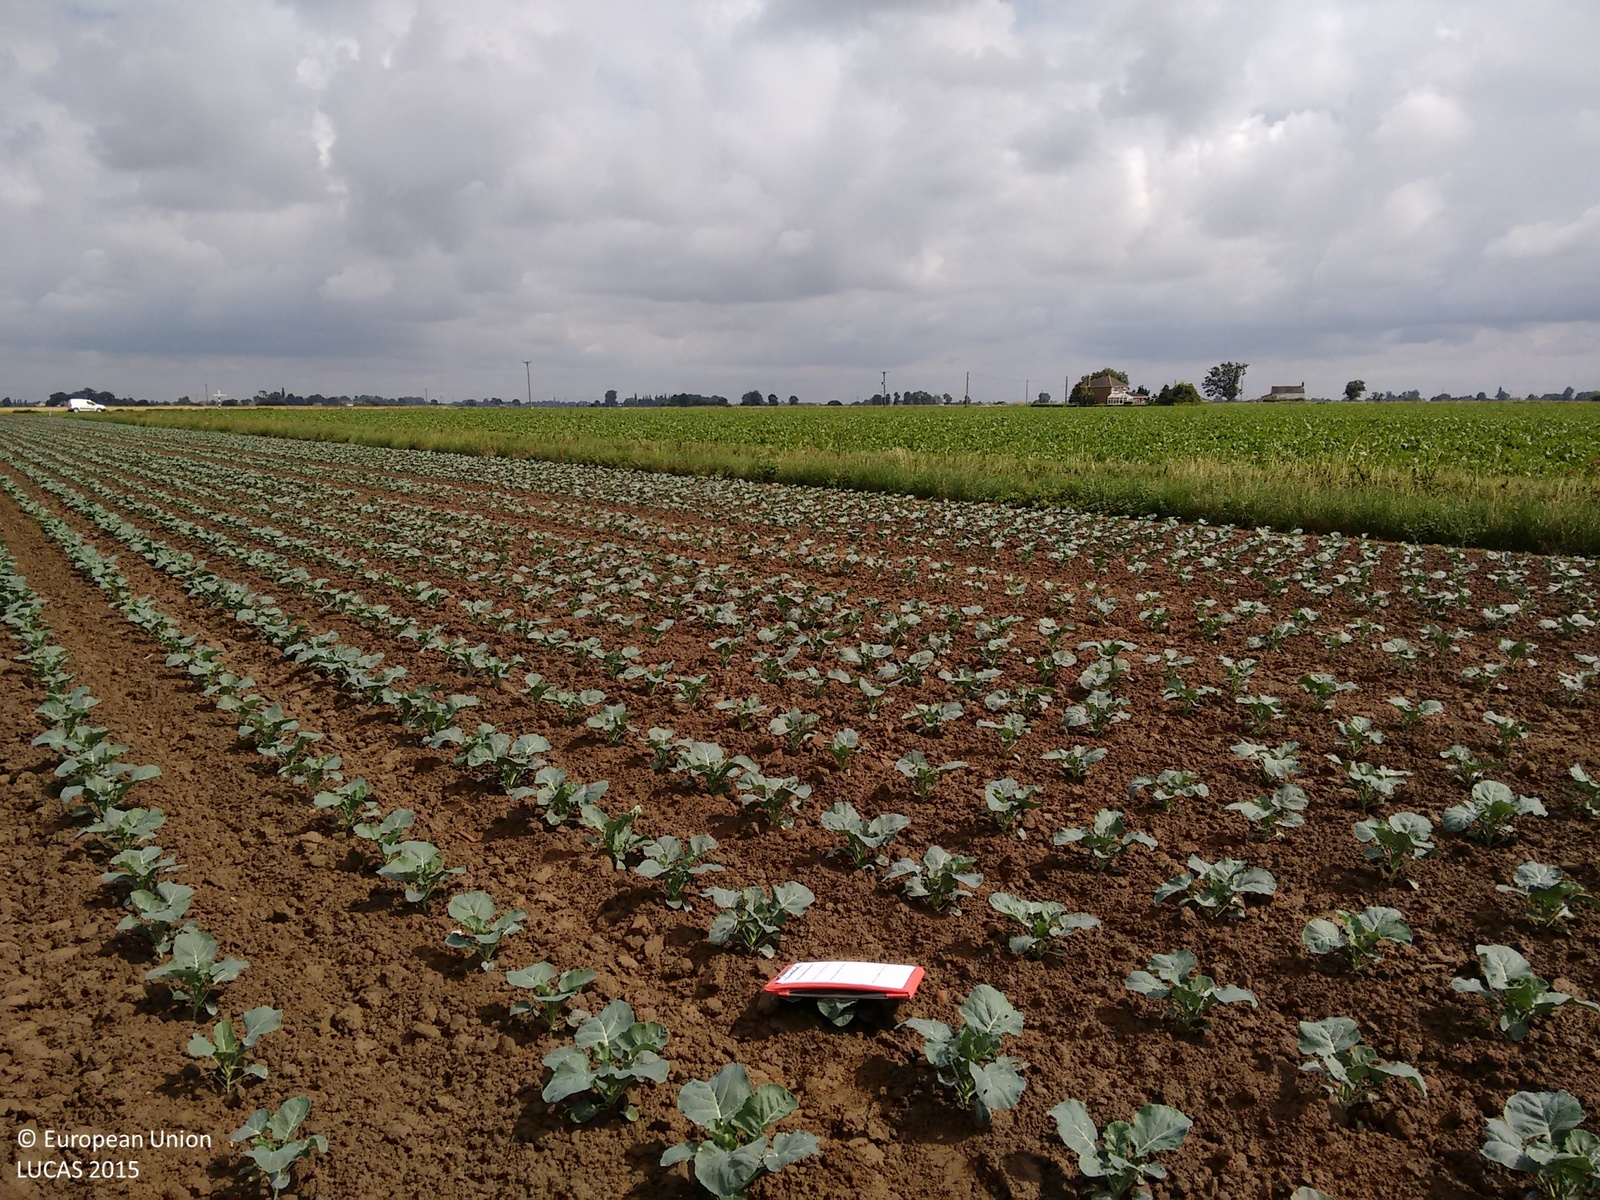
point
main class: Cropland
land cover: Other fresh vegetables
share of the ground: > 75 %
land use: Agriculture (excluding fallow land and kitchen gardens)
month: July
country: GB
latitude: 52.7615
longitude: -0.0955
